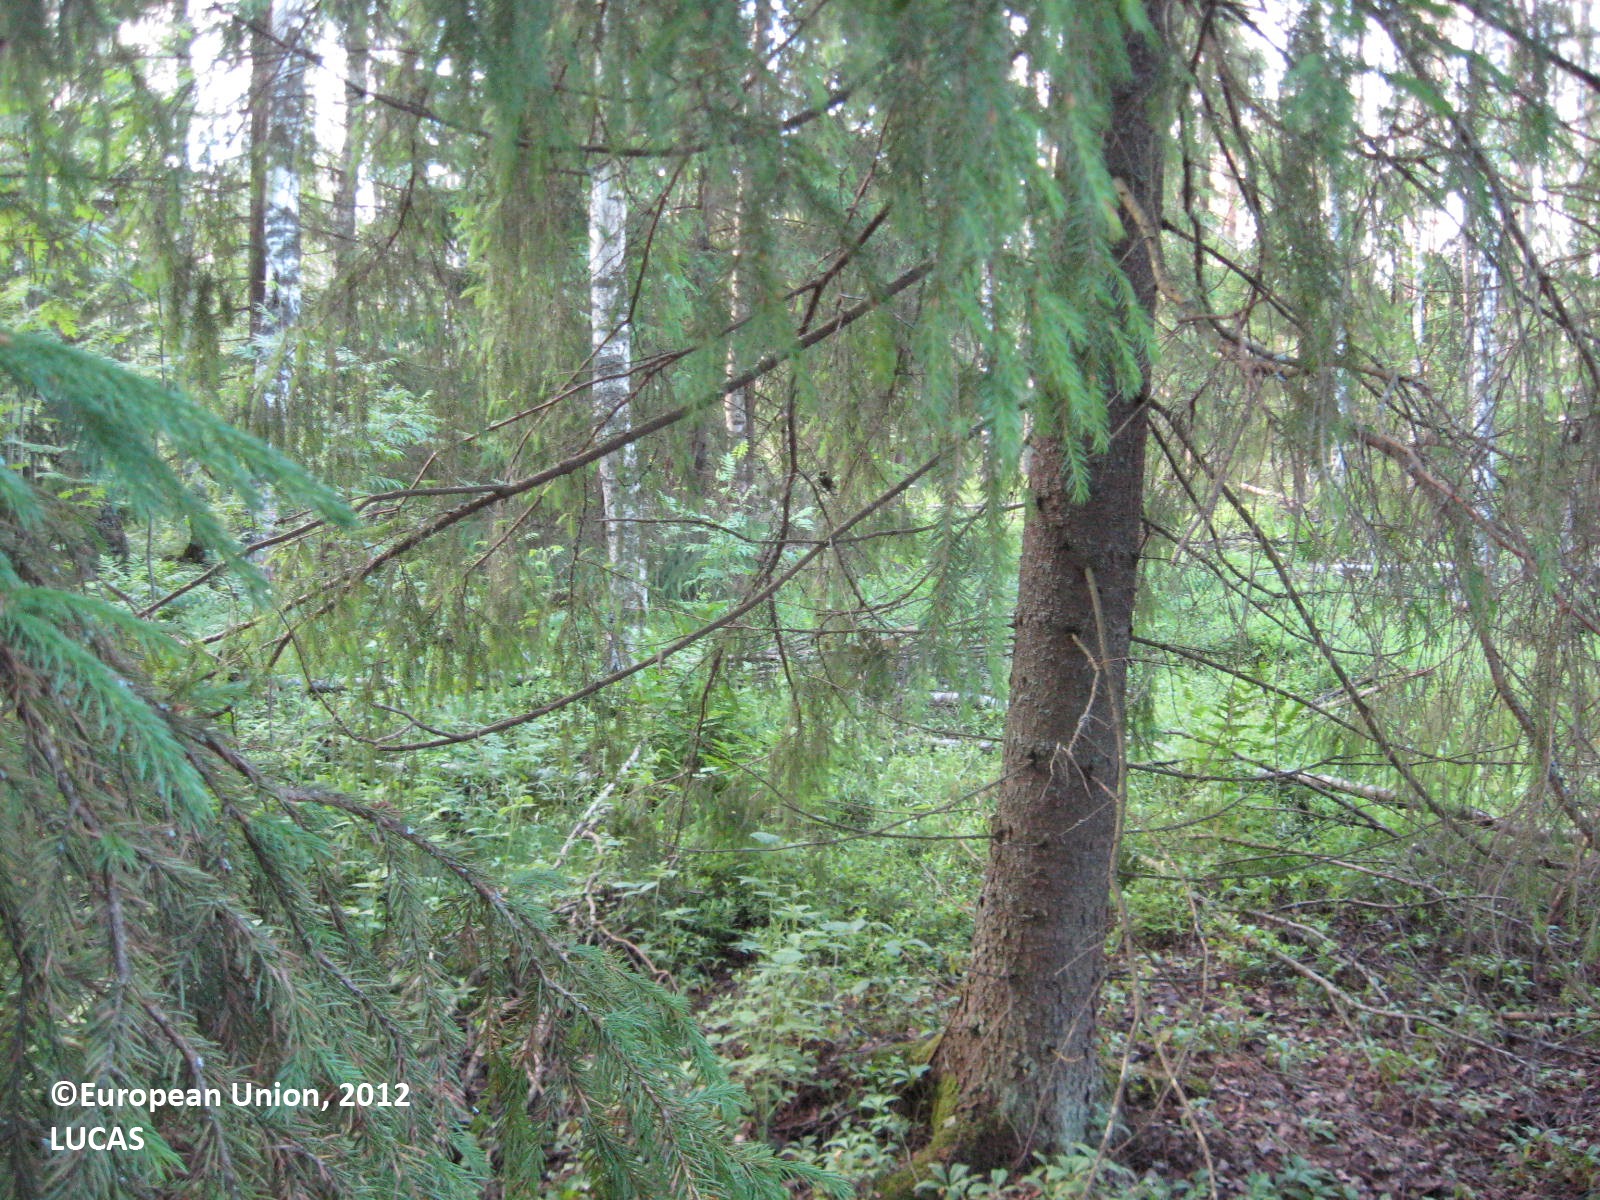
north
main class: Woodland
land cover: Other mixed woodland
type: boreal forest
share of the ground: > 75 %
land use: Forestry
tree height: > 5 m
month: June
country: FI
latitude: 62.9067
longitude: 22.7900
